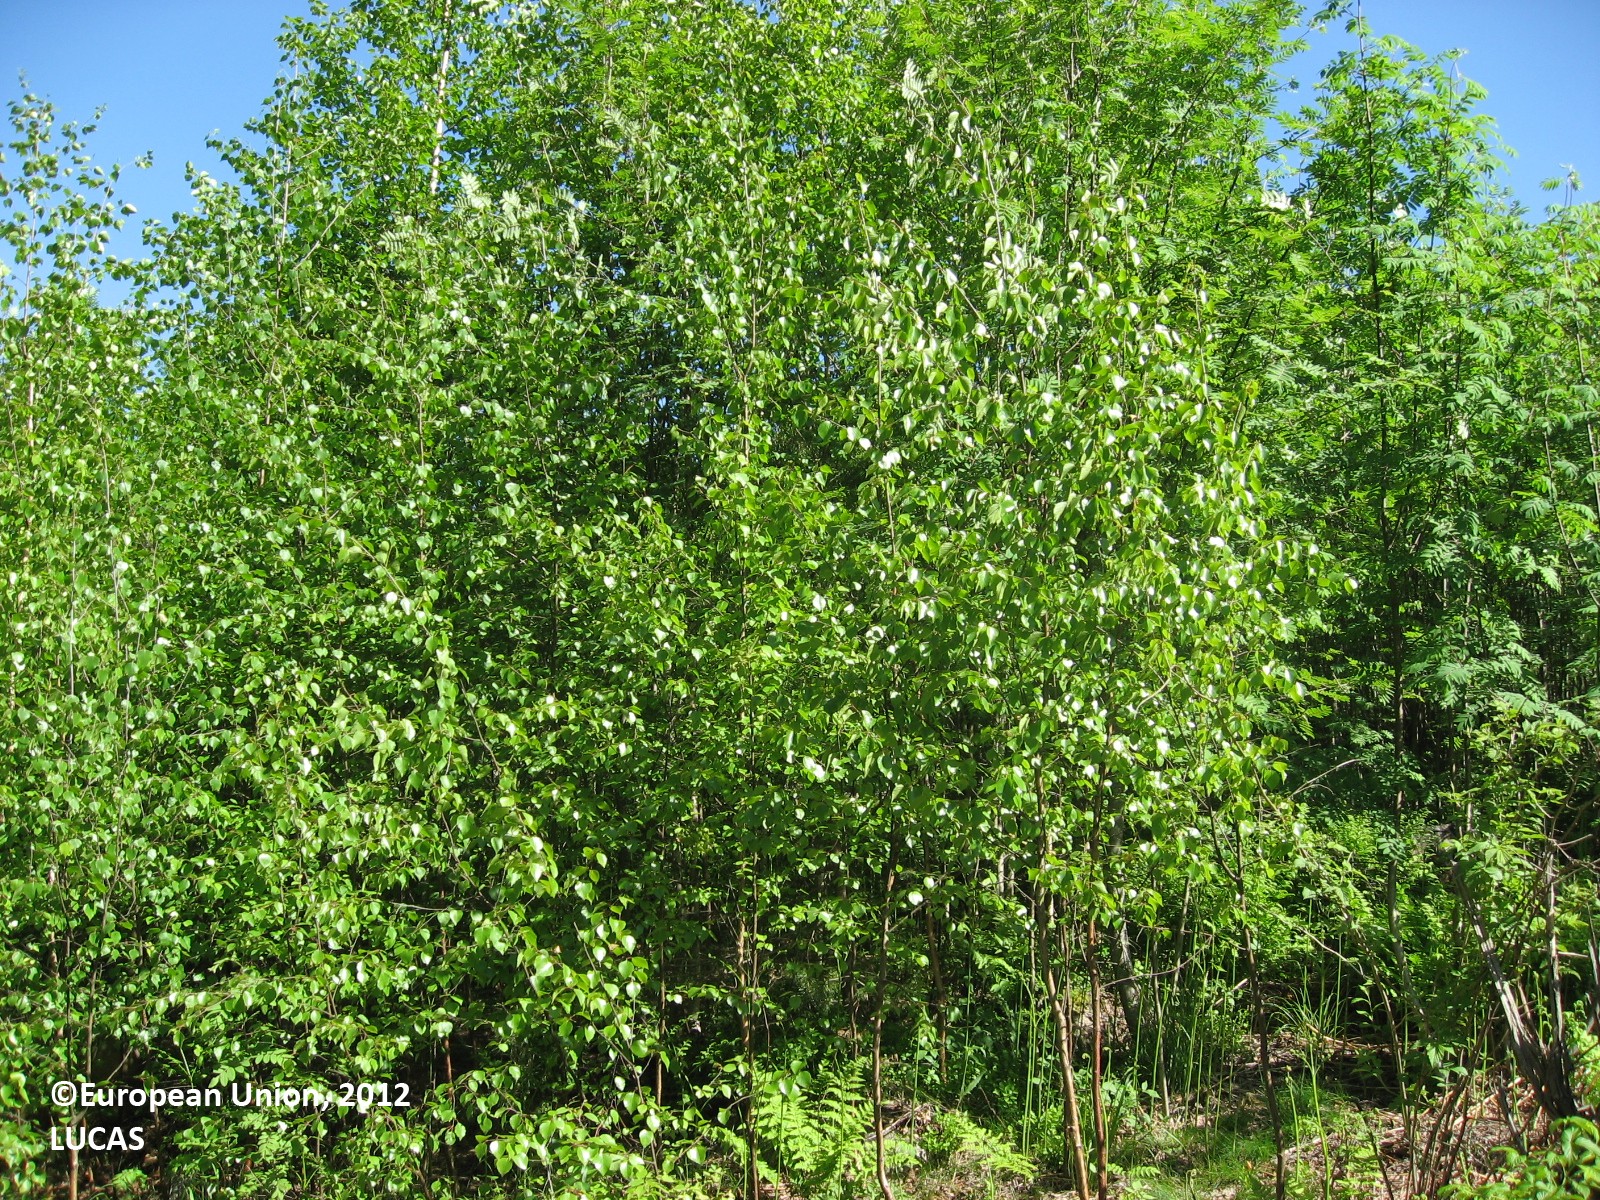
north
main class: Woodland
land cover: Broadleaved woodland
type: boreal forest
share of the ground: > 75 %
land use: Forestry
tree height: > 5 m
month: June
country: FI
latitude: 60.3644
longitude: 25.3374
